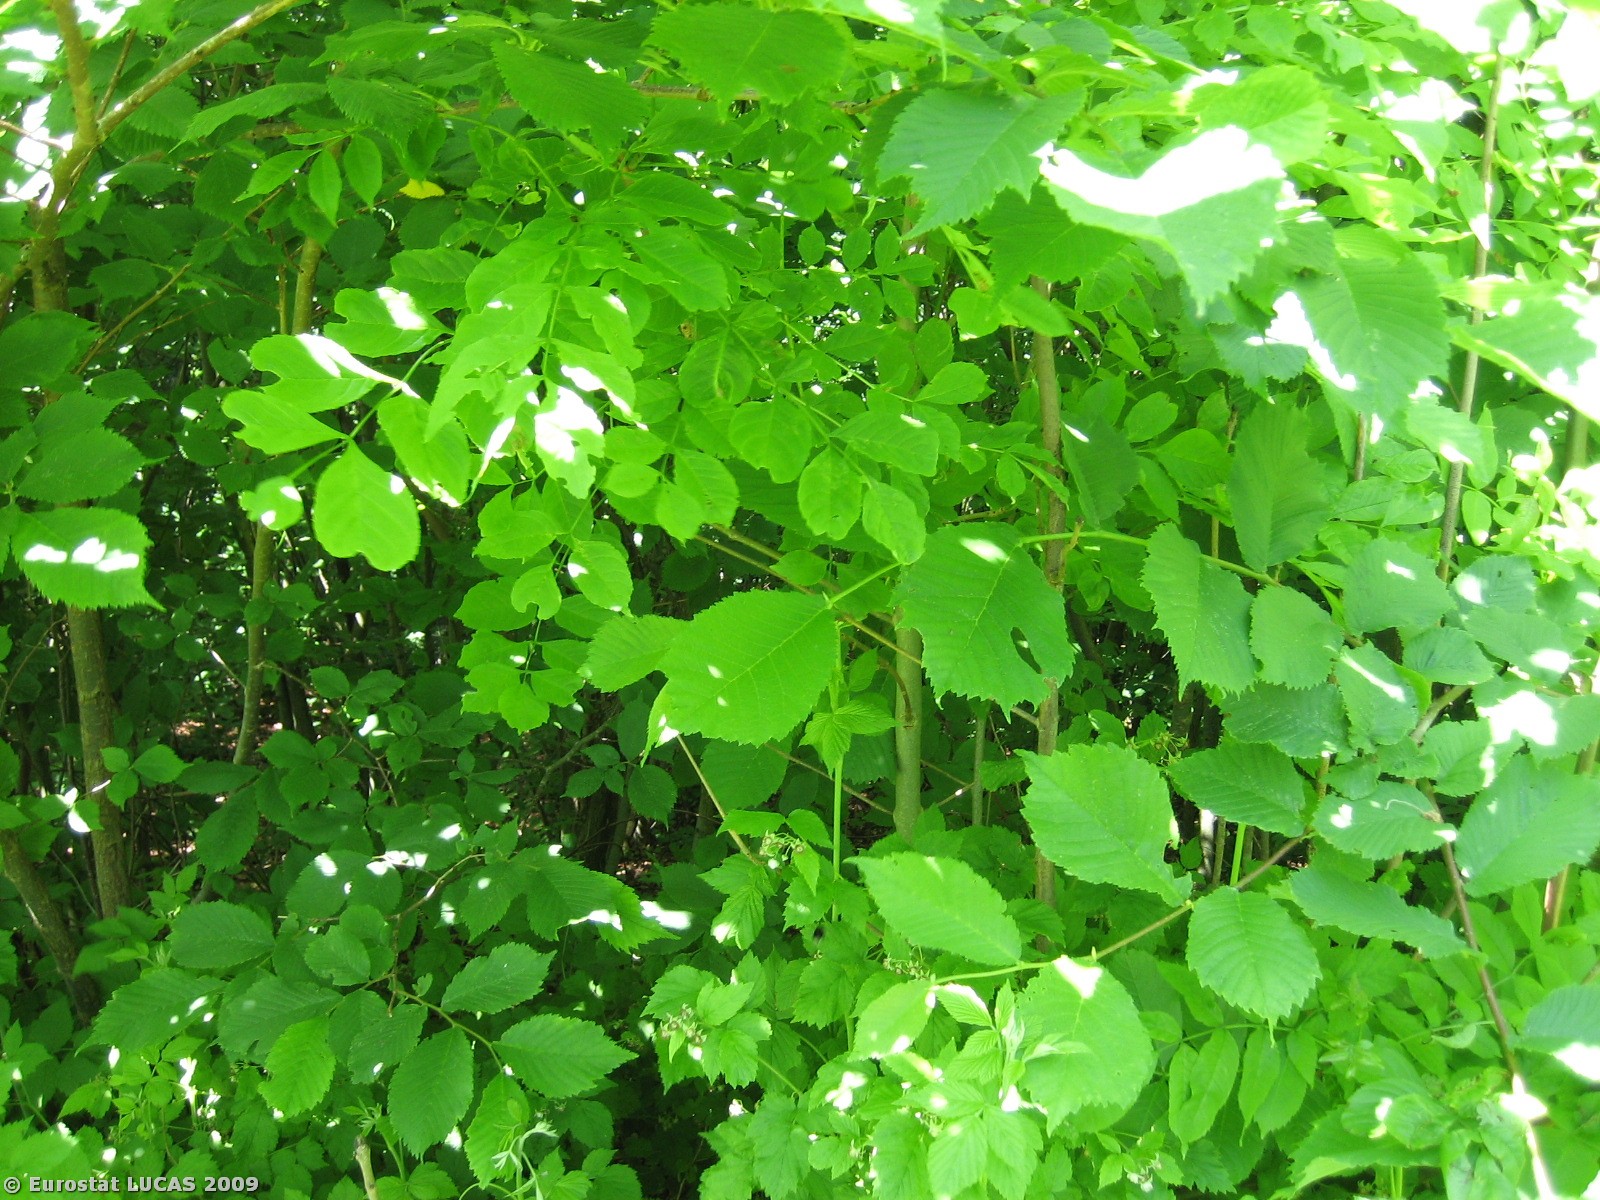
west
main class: Woodland
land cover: Broadleaved woodland
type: mesophytic deciduous forest
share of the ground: > 75 %
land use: Residential
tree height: > 5 m
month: June
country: DK
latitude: 55.9540
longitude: 9.8560
